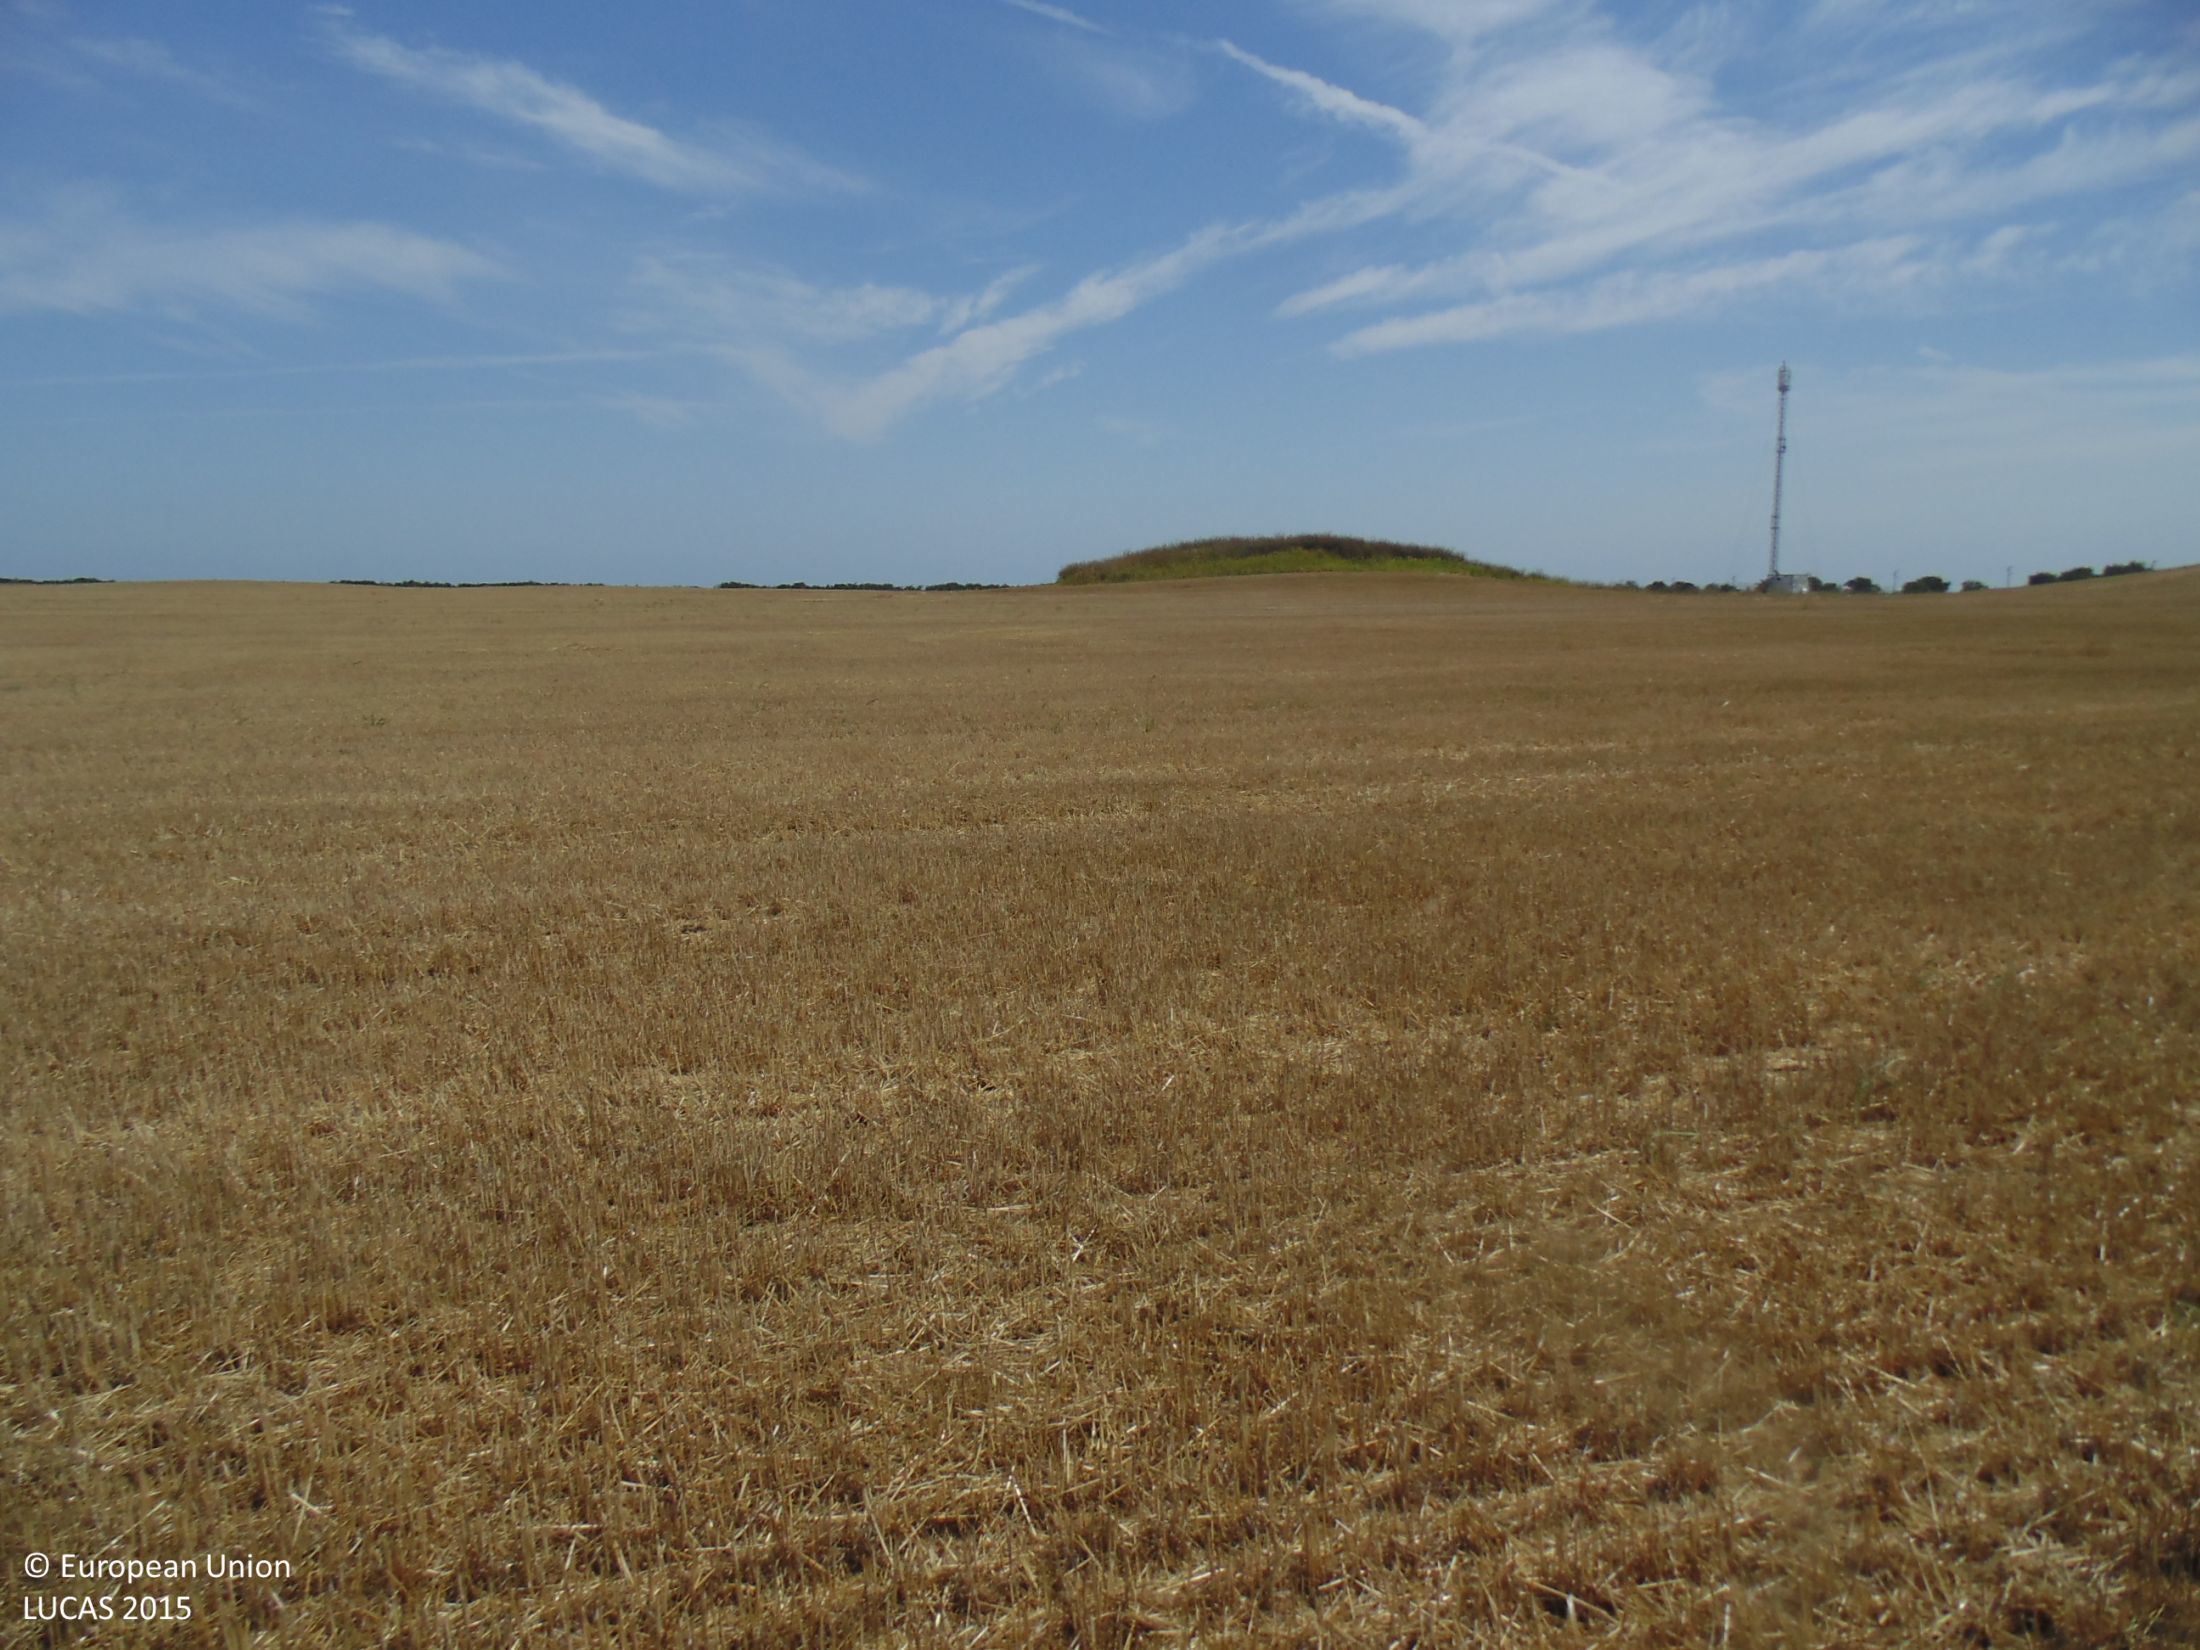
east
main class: Cropland
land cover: Common wheat
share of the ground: 25 - 50 %
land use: Agriculture (excluding fallow land and kitchen gardens)
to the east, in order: Common wheat
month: August
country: BG
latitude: 43.6262
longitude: 28.5178
